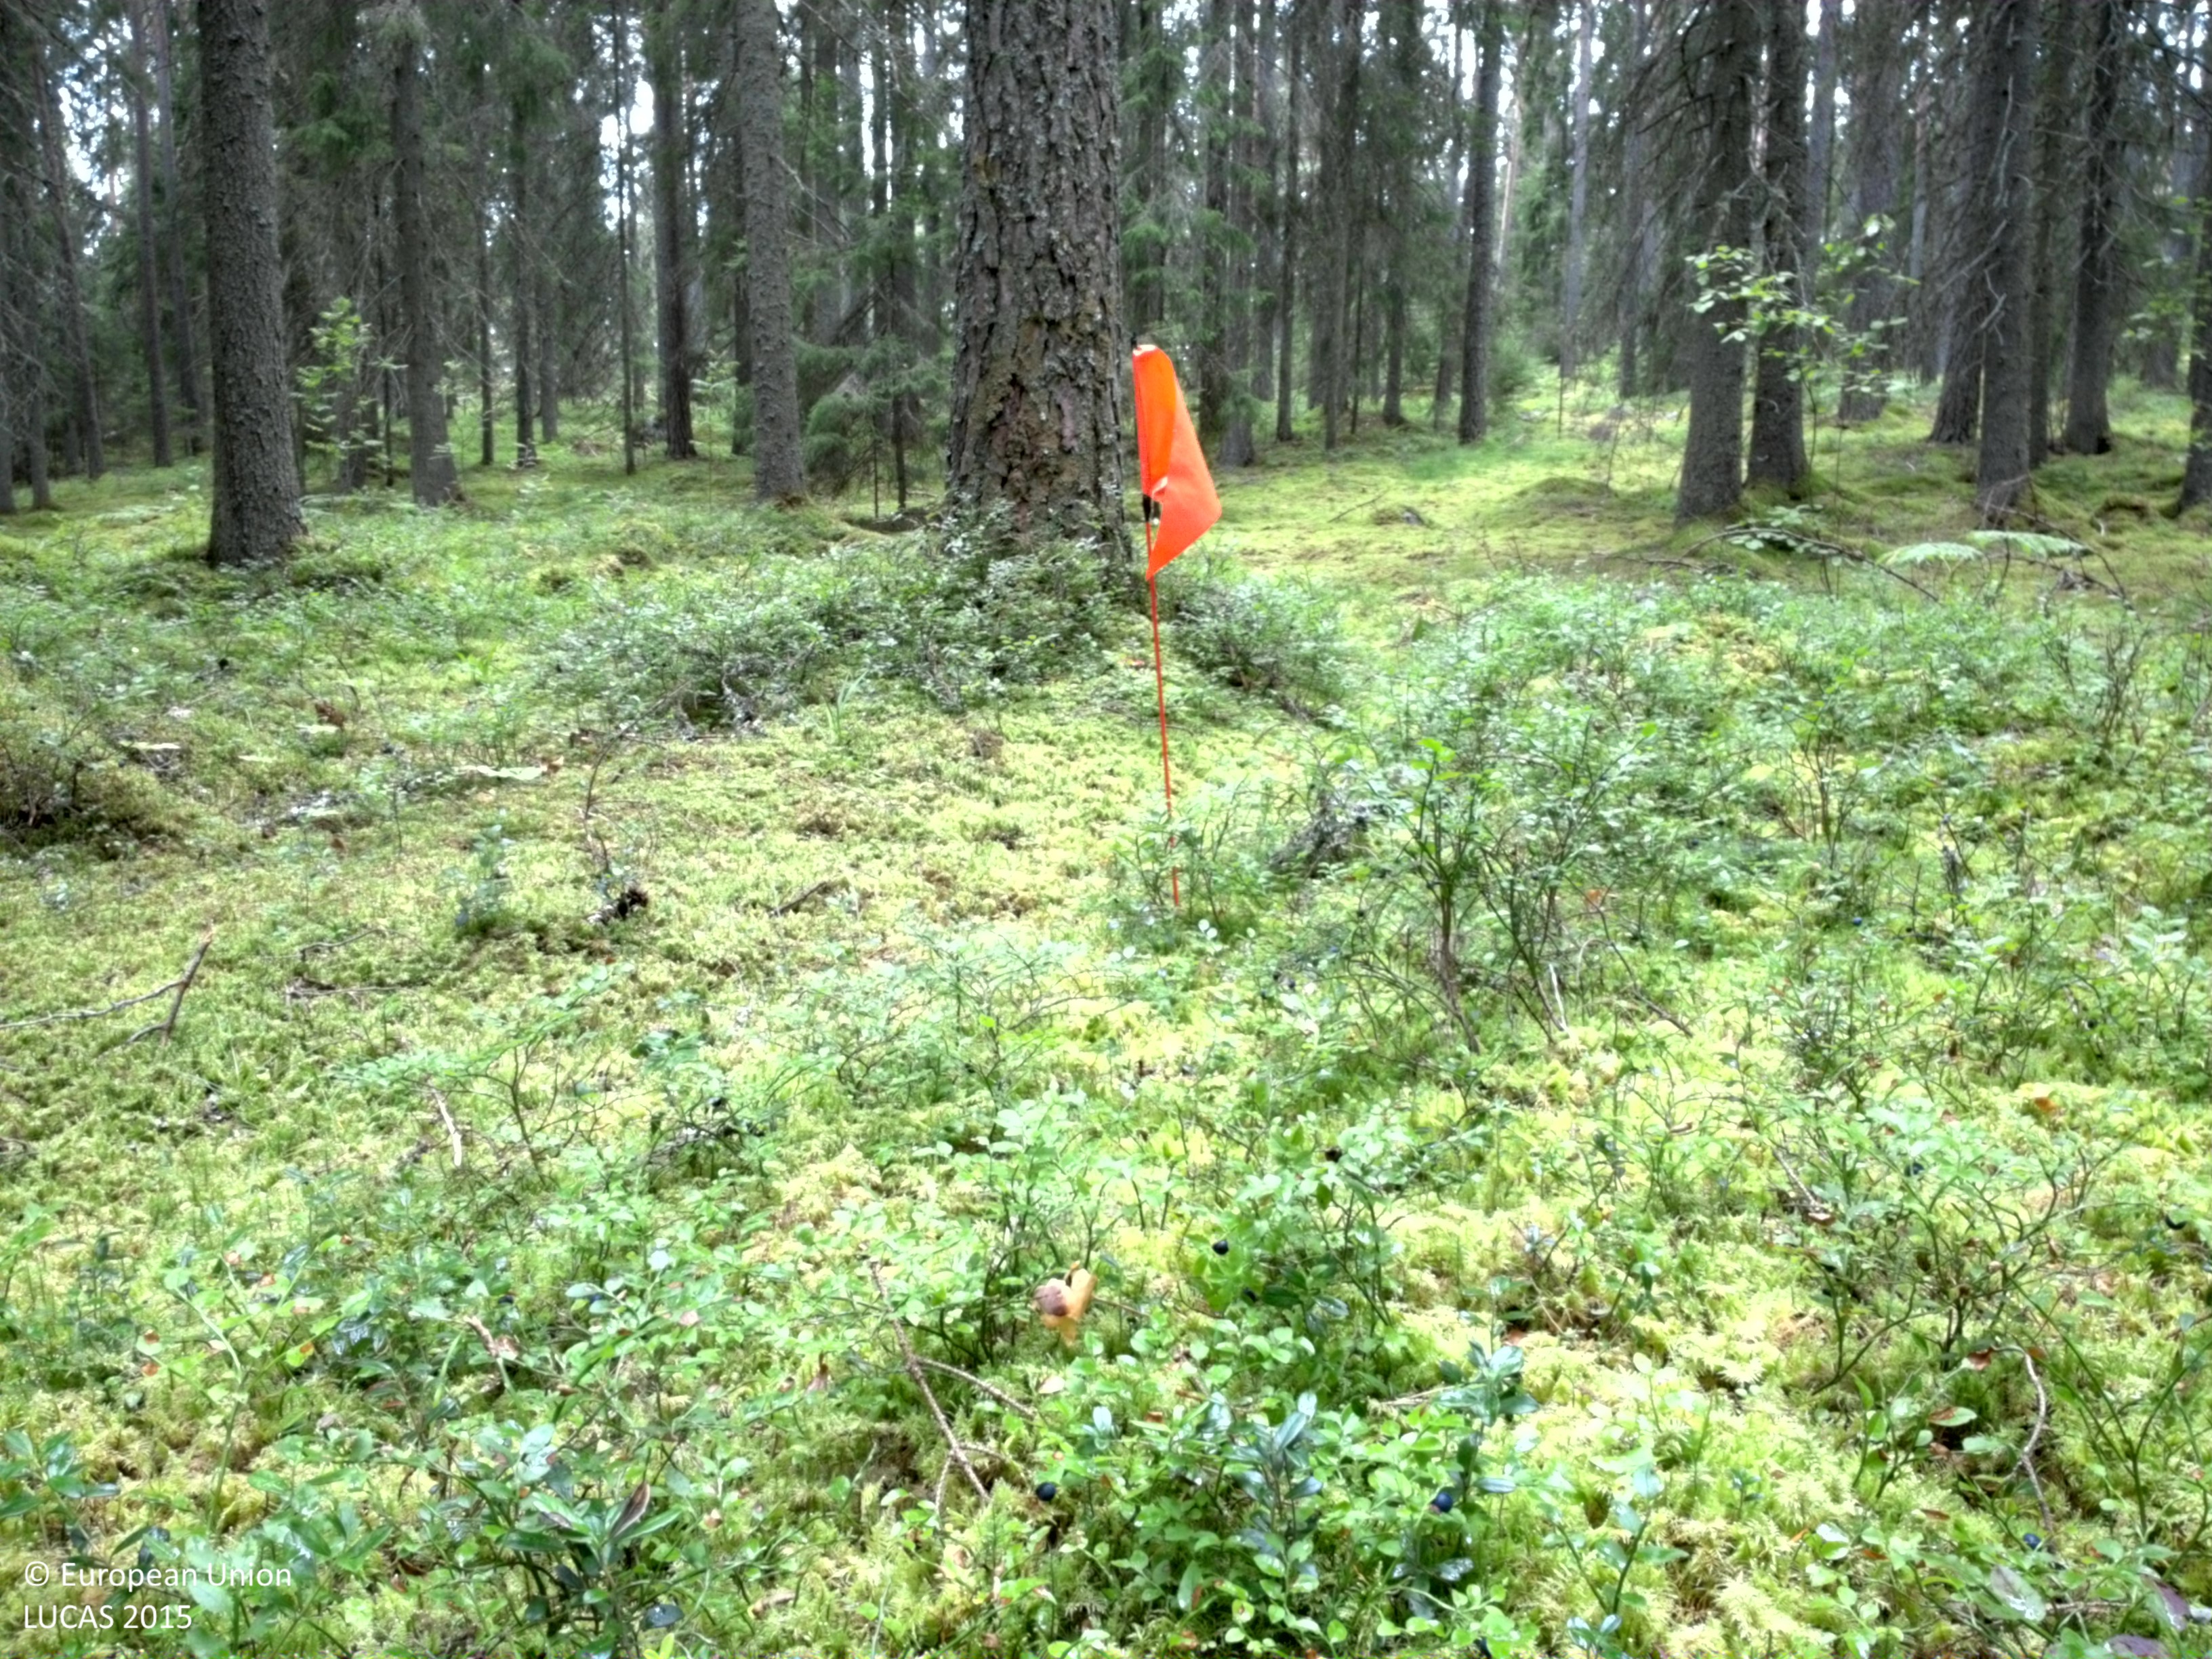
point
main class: Woodland
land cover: Spruce dominated coniferous woodland
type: boreal forest
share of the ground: > 75 %
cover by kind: coniferous forest trees 80 %, lichens and mosses 10 %, broadleaved forest trees 5 %, shrubs 5 %
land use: Forestry
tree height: > 5 m
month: August
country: SE
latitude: 59.8890
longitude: 16.4421
